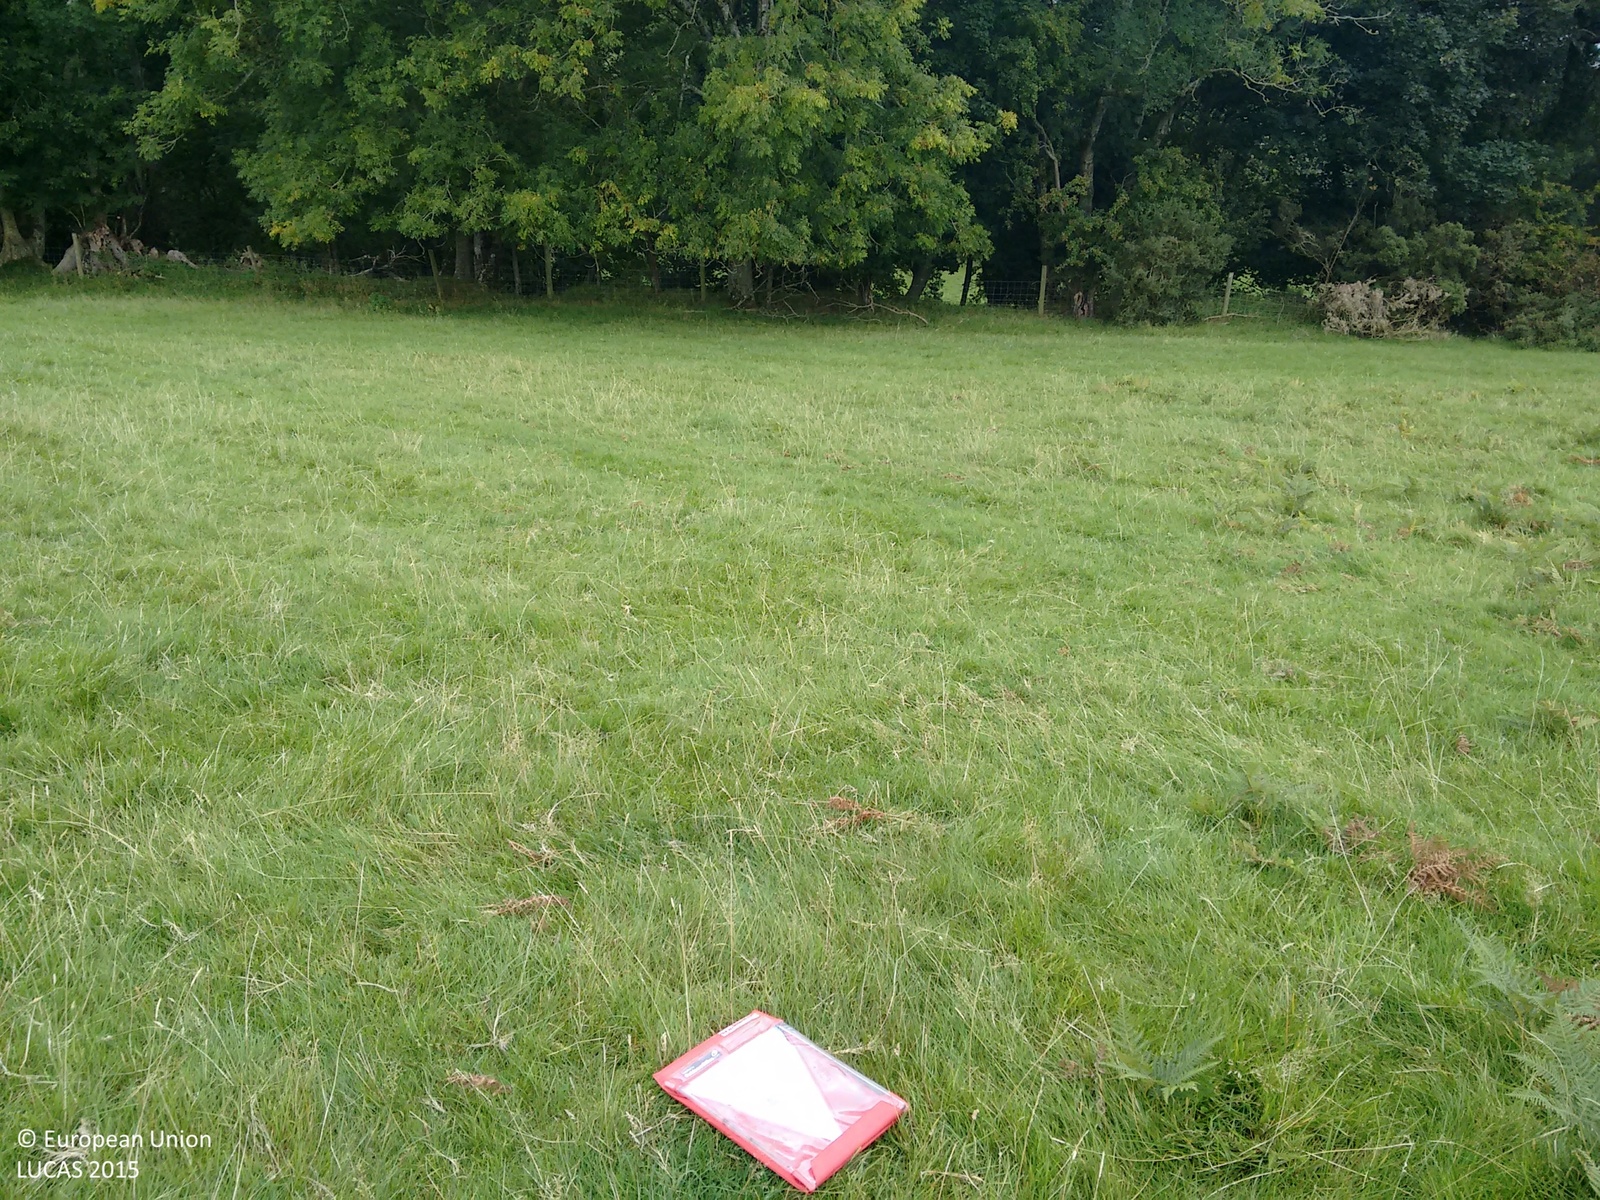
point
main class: Grassland
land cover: Grassland without tree/shrub cover
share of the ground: > 75 %
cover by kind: herbaceous plants 100 %
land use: Agriculture (excluding fallow land and kitchen gardens)
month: September
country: GB
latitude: 52.1320
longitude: -4.5549
